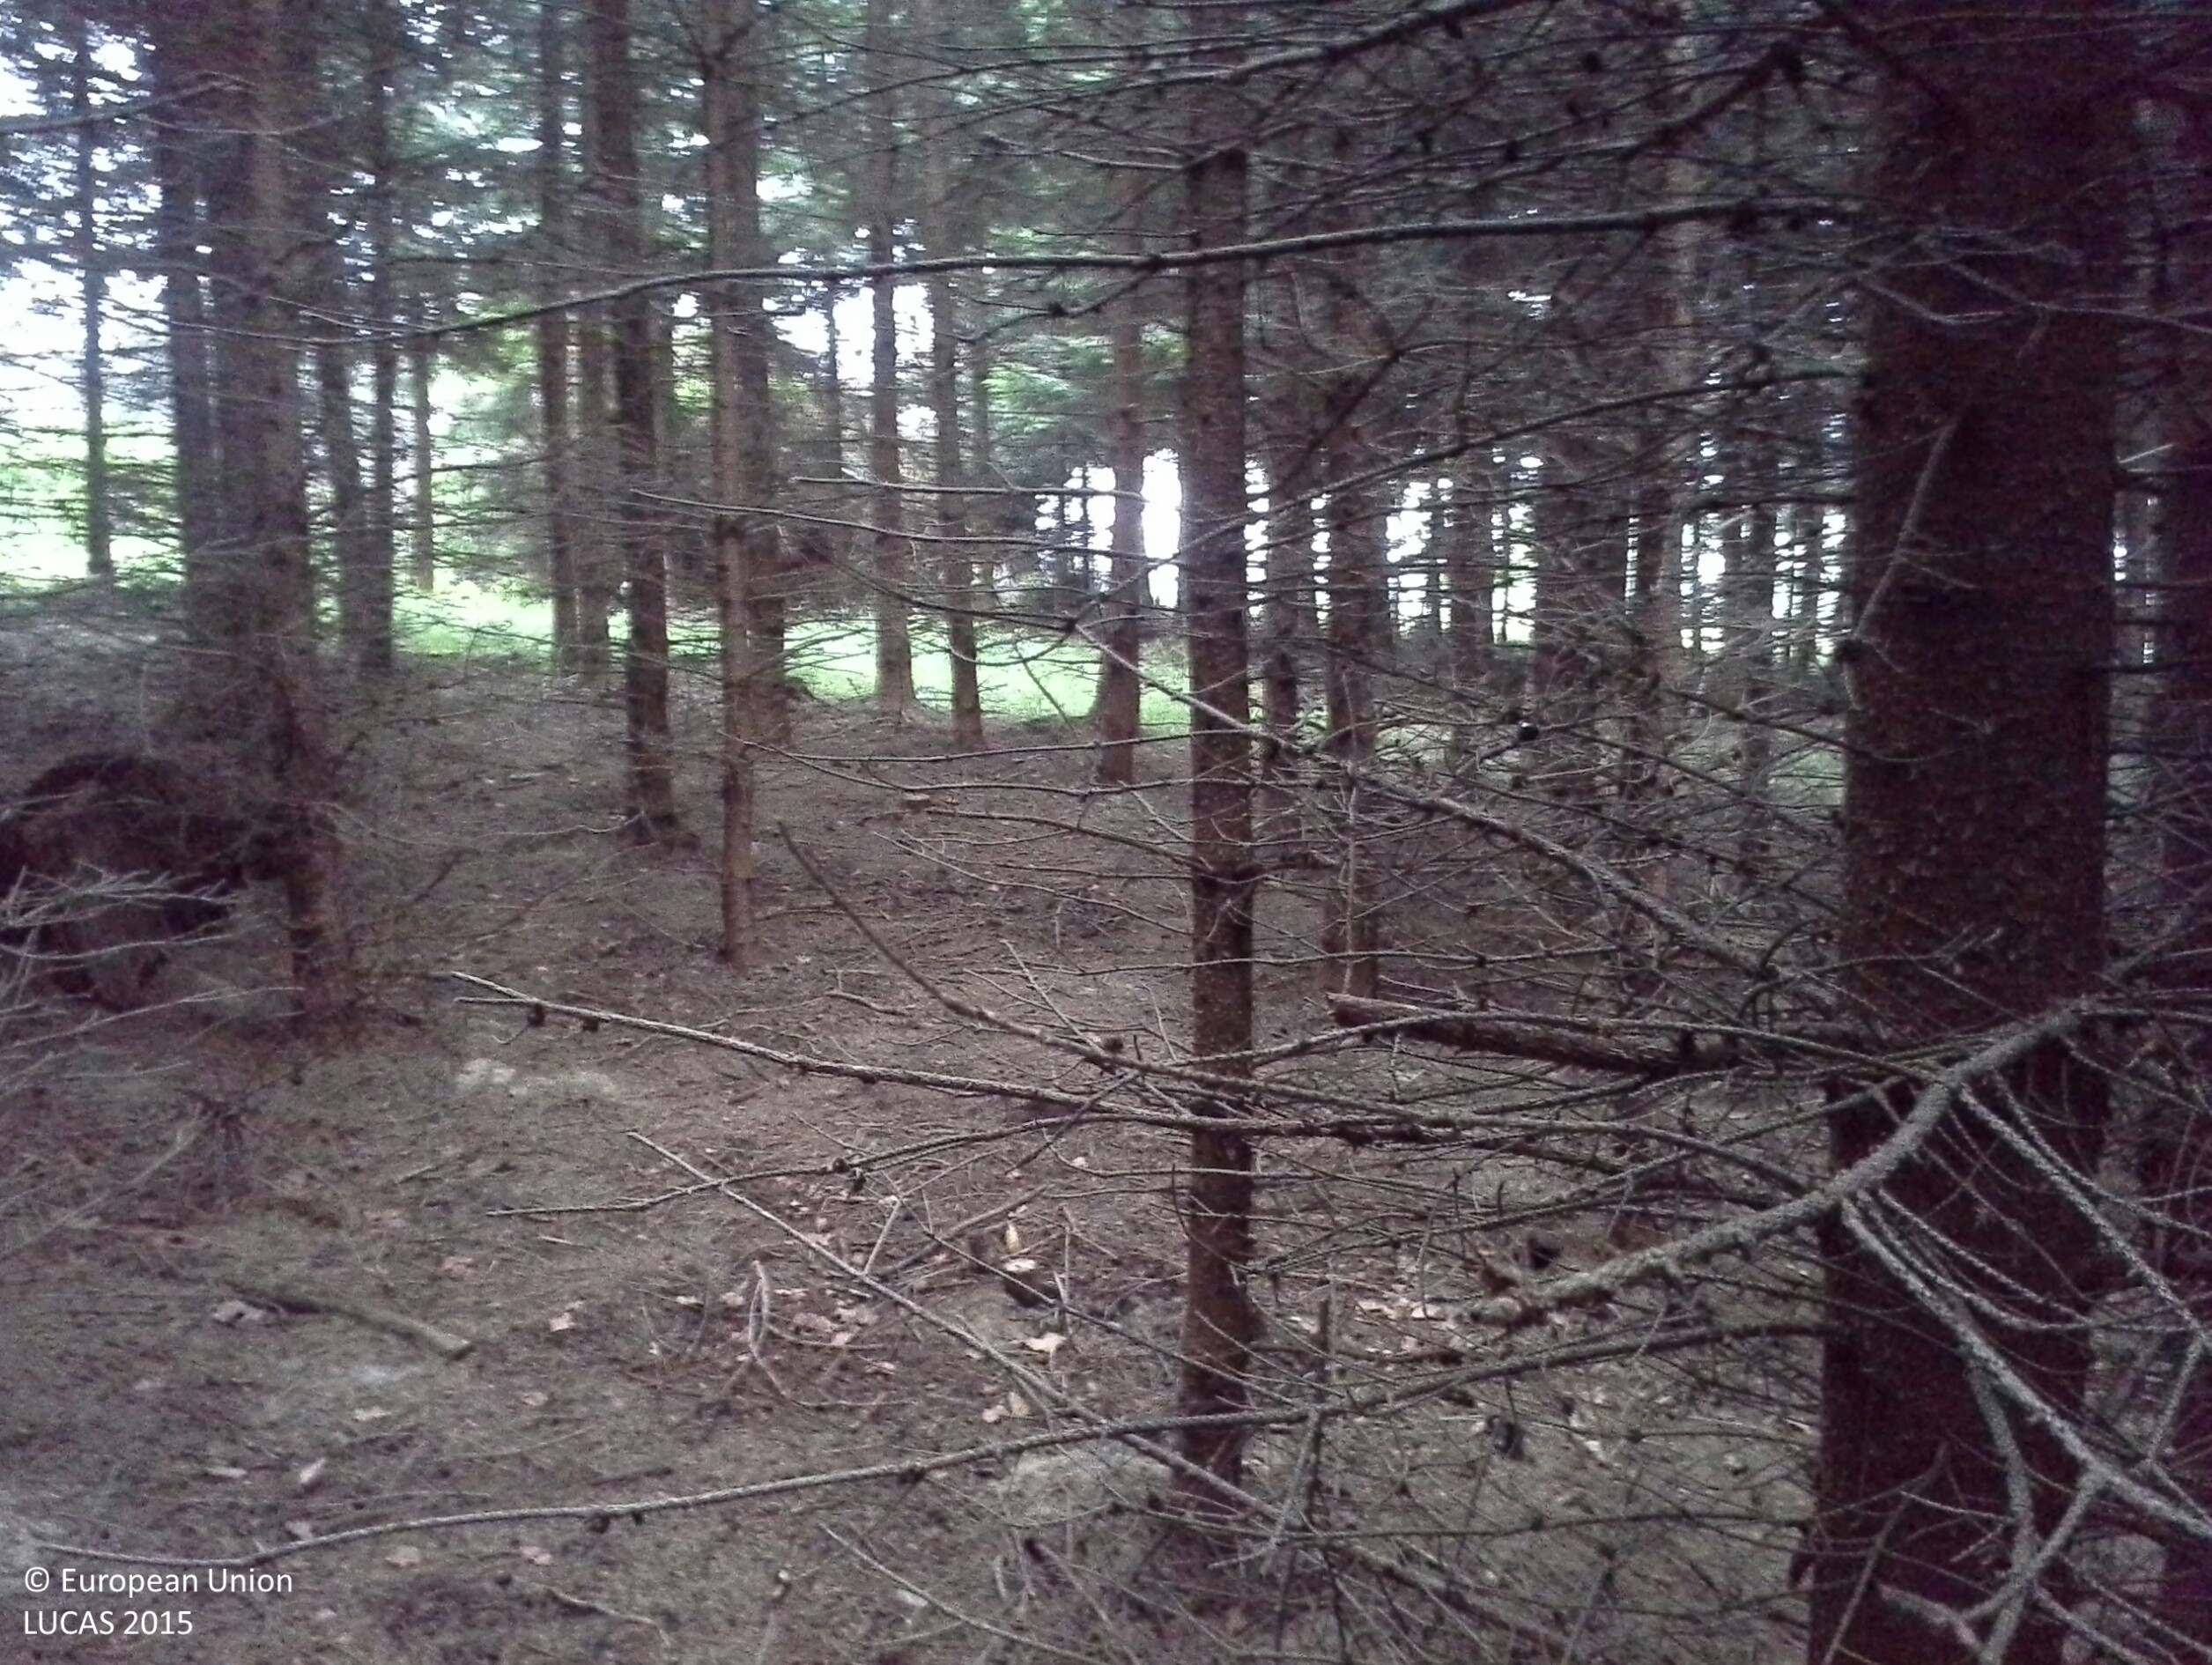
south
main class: Woodland
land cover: Spruce dominated coniferous woodland
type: hemiboreal forest and nemoral coniferous forest and mixed broadleaved-coniferous forest
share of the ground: > 75 %
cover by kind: coniferous forest trees 100 %
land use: Forestry
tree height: > 5 m
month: July
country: AT
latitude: 48.0149
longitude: 14.7060
